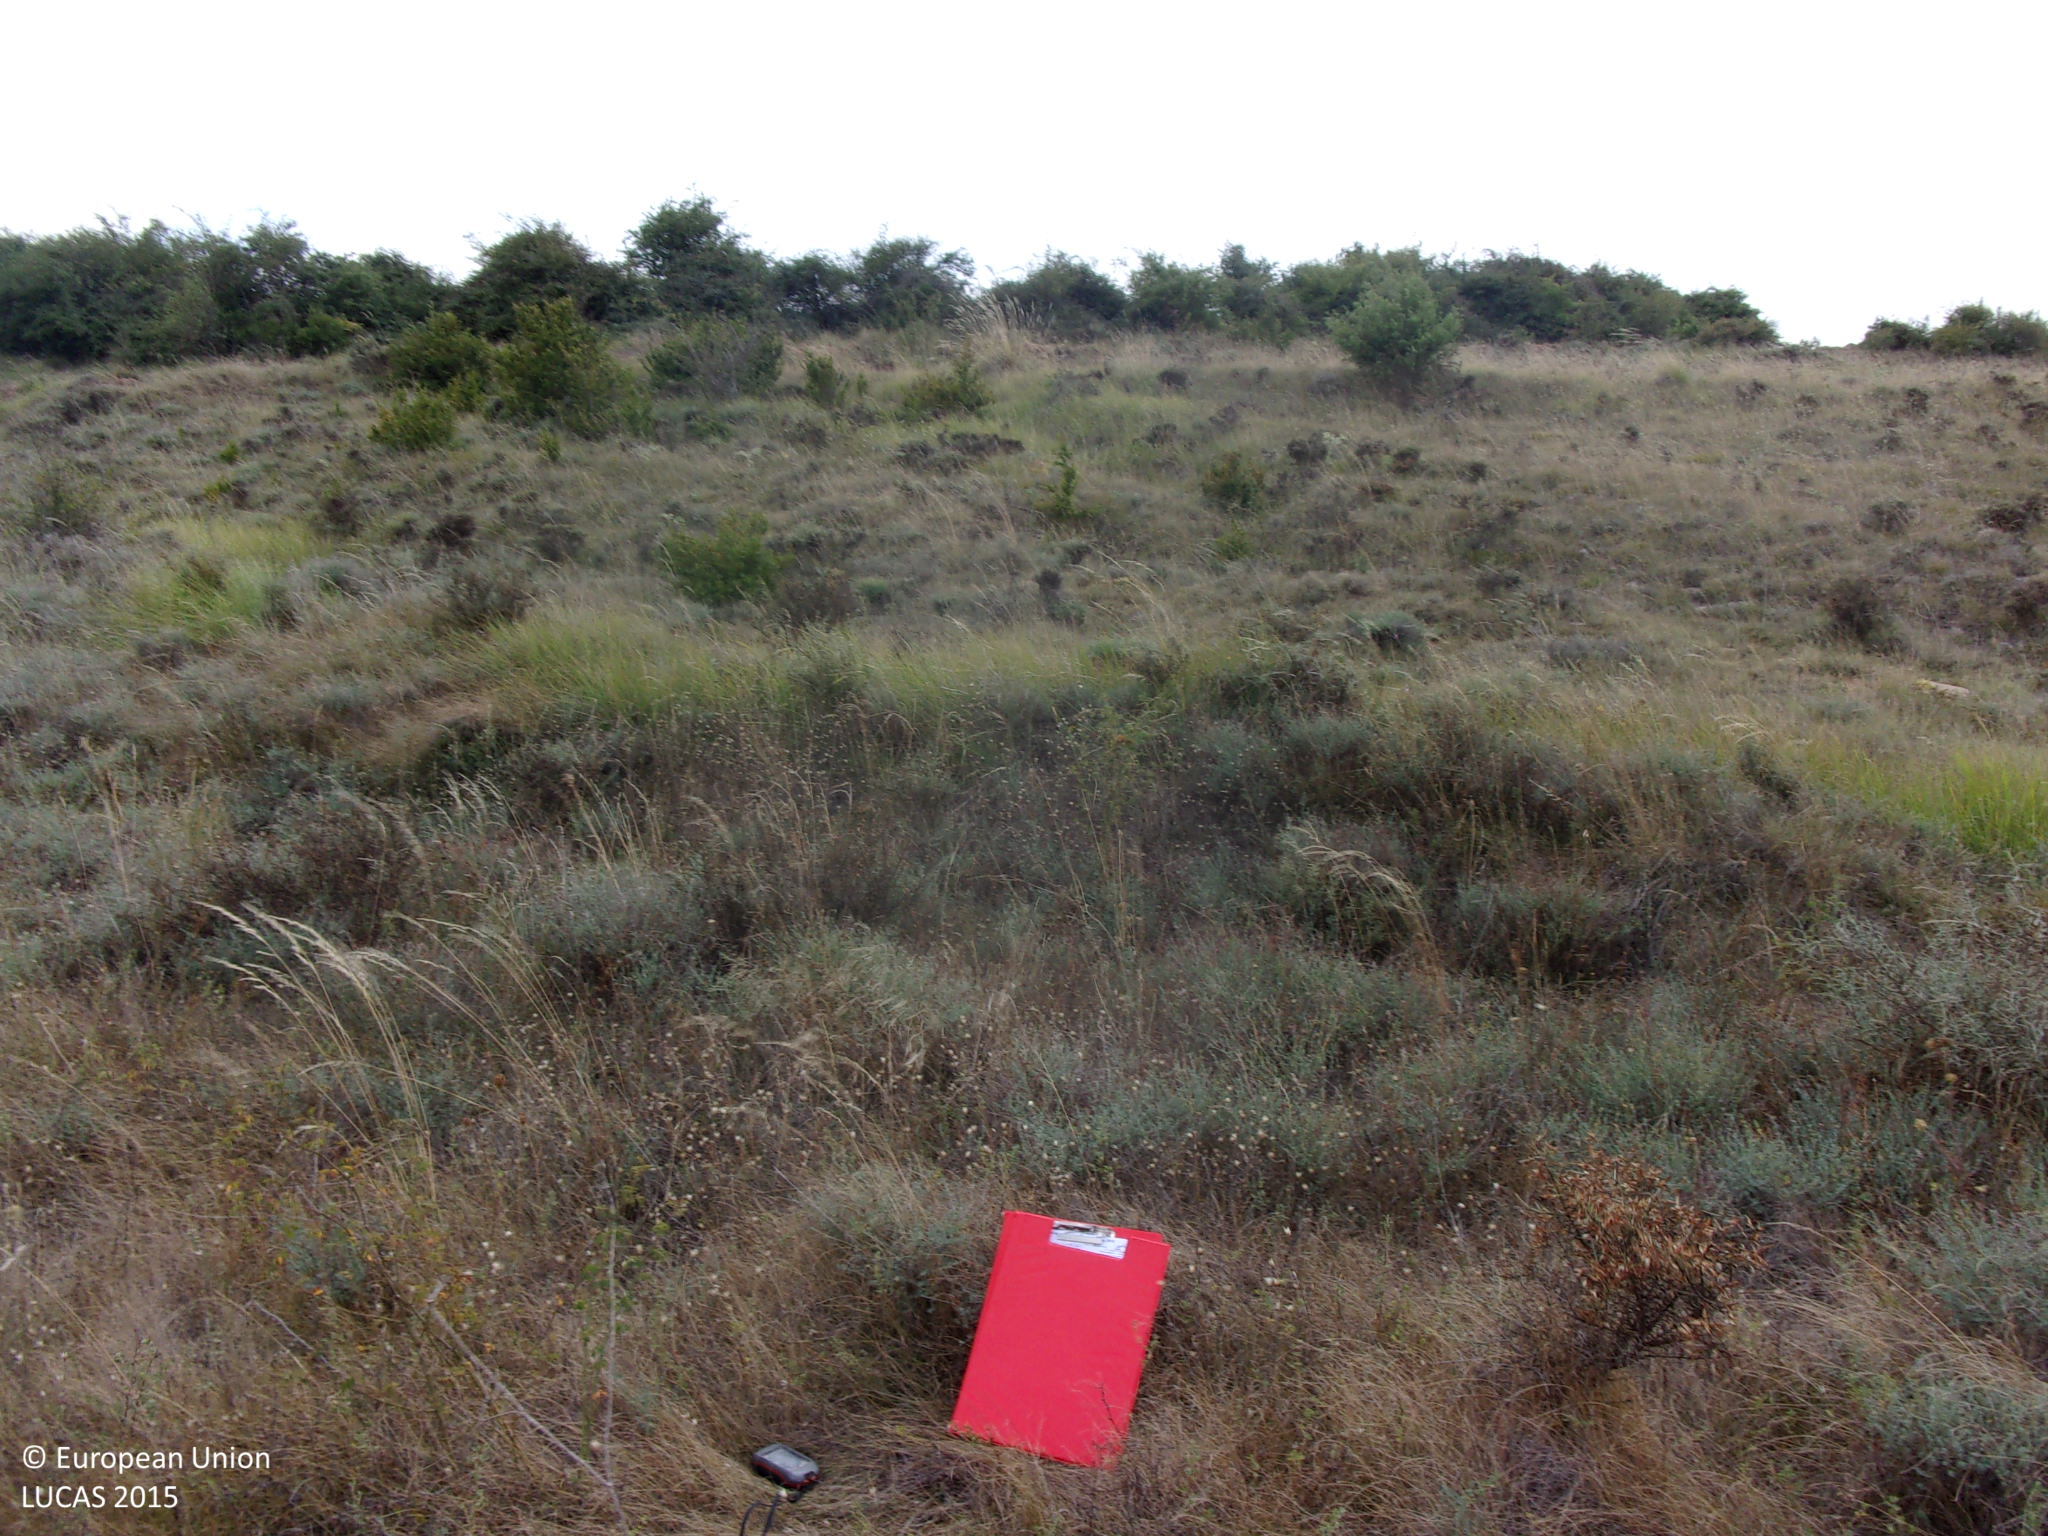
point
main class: Grassland
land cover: Grassland without tree/shrub cover
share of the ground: > 75 %
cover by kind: herbaceous plants 100 %
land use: Abandoned areas
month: August
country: ES
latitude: 42.5669
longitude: -1.1293
